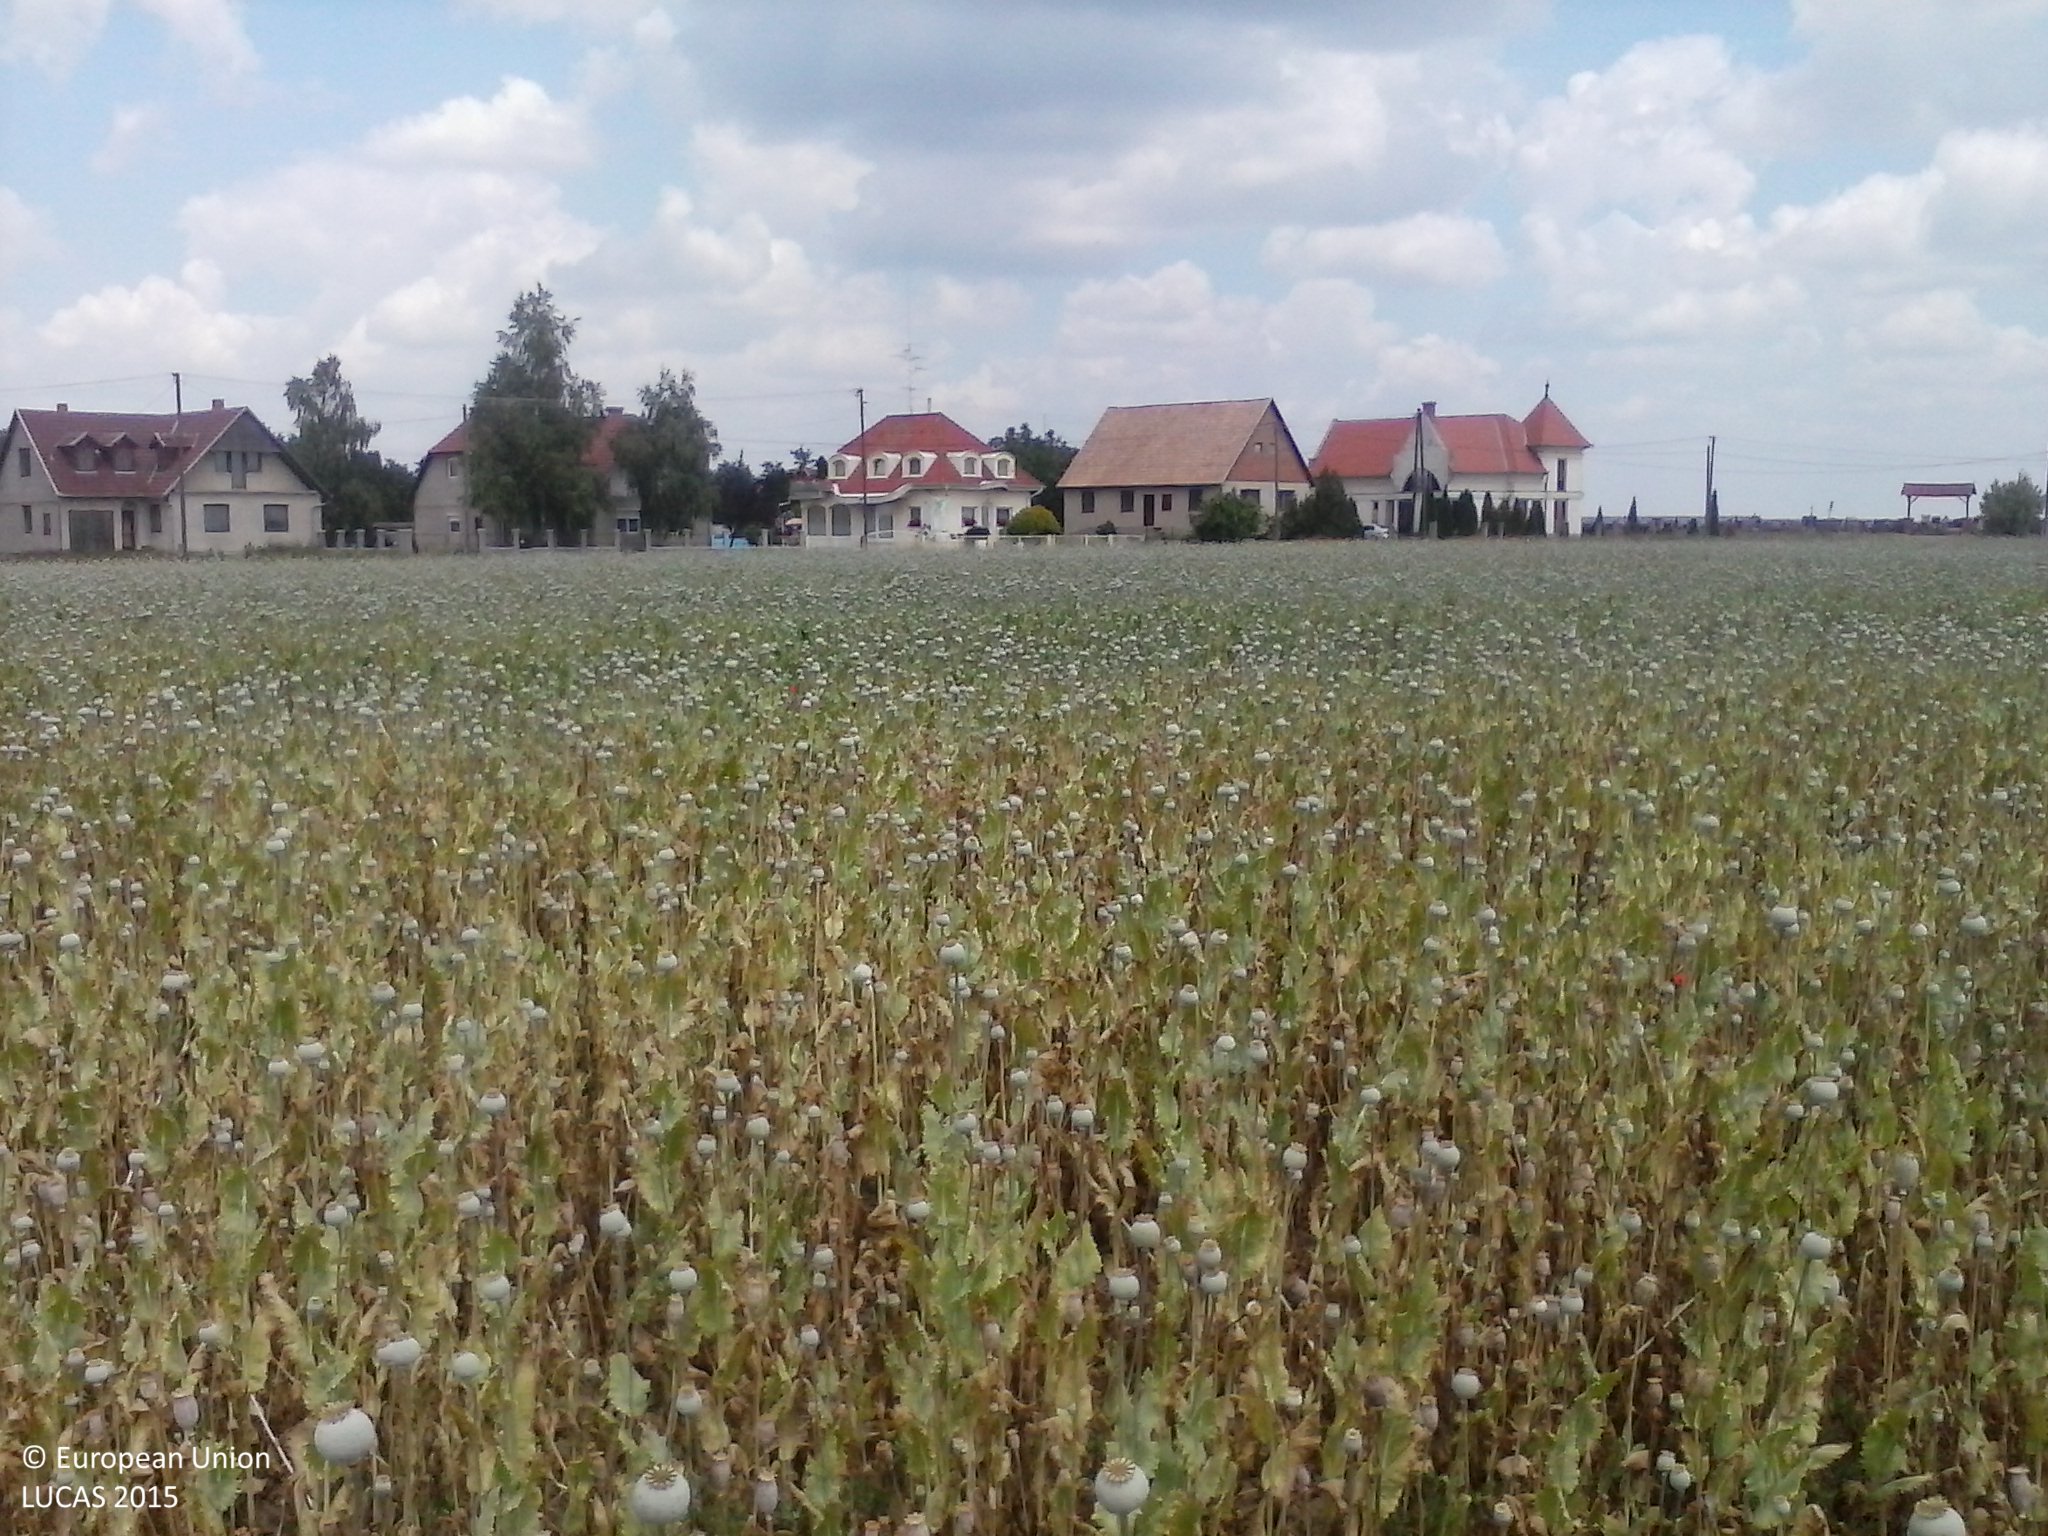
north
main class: Cropland
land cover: Other fibre and oleaginous crops
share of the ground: > 75 %
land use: Agriculture (excluding fallow land and kitchen gardens)
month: June
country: HU
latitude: 46.2718
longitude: 19.5020
